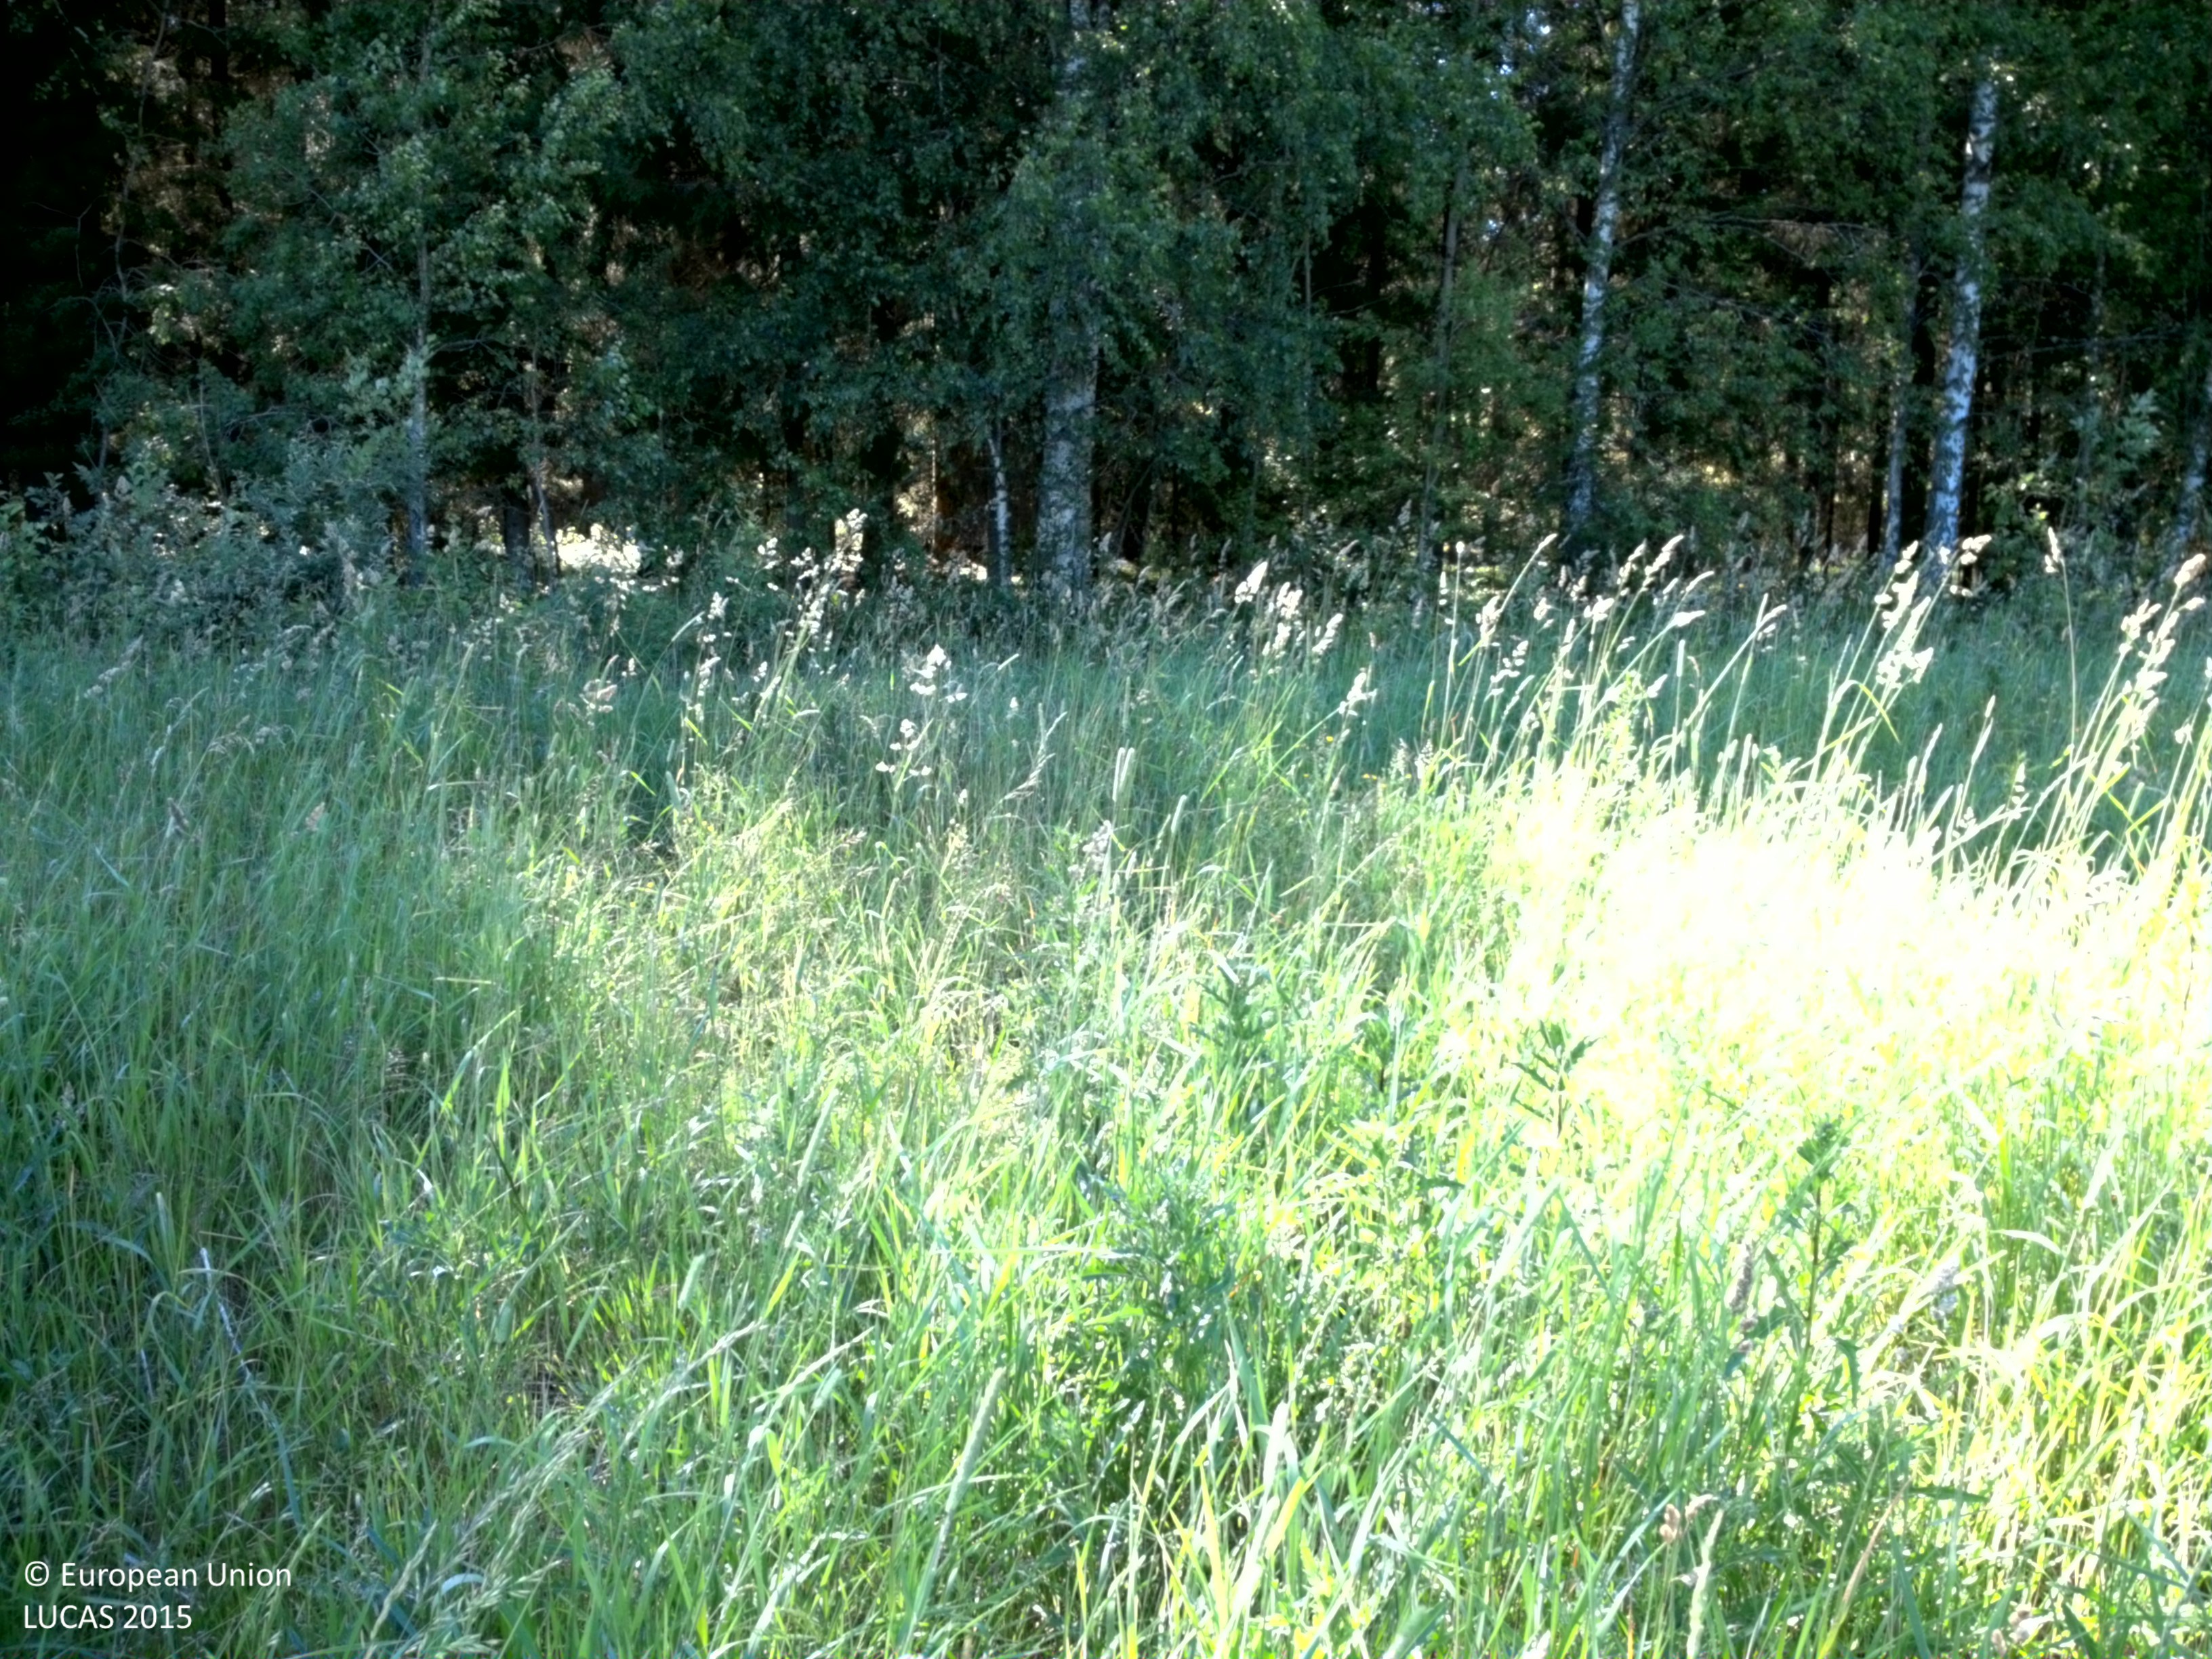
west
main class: Grassland
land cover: Grassland without tree/shrub cover
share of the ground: > 75 %
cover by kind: herbaceous plants 100 %
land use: Agriculture (excluding fallow land and kitchen gardens)
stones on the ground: < 10 %
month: July
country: SE
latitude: 59.7143
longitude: 18.3714
